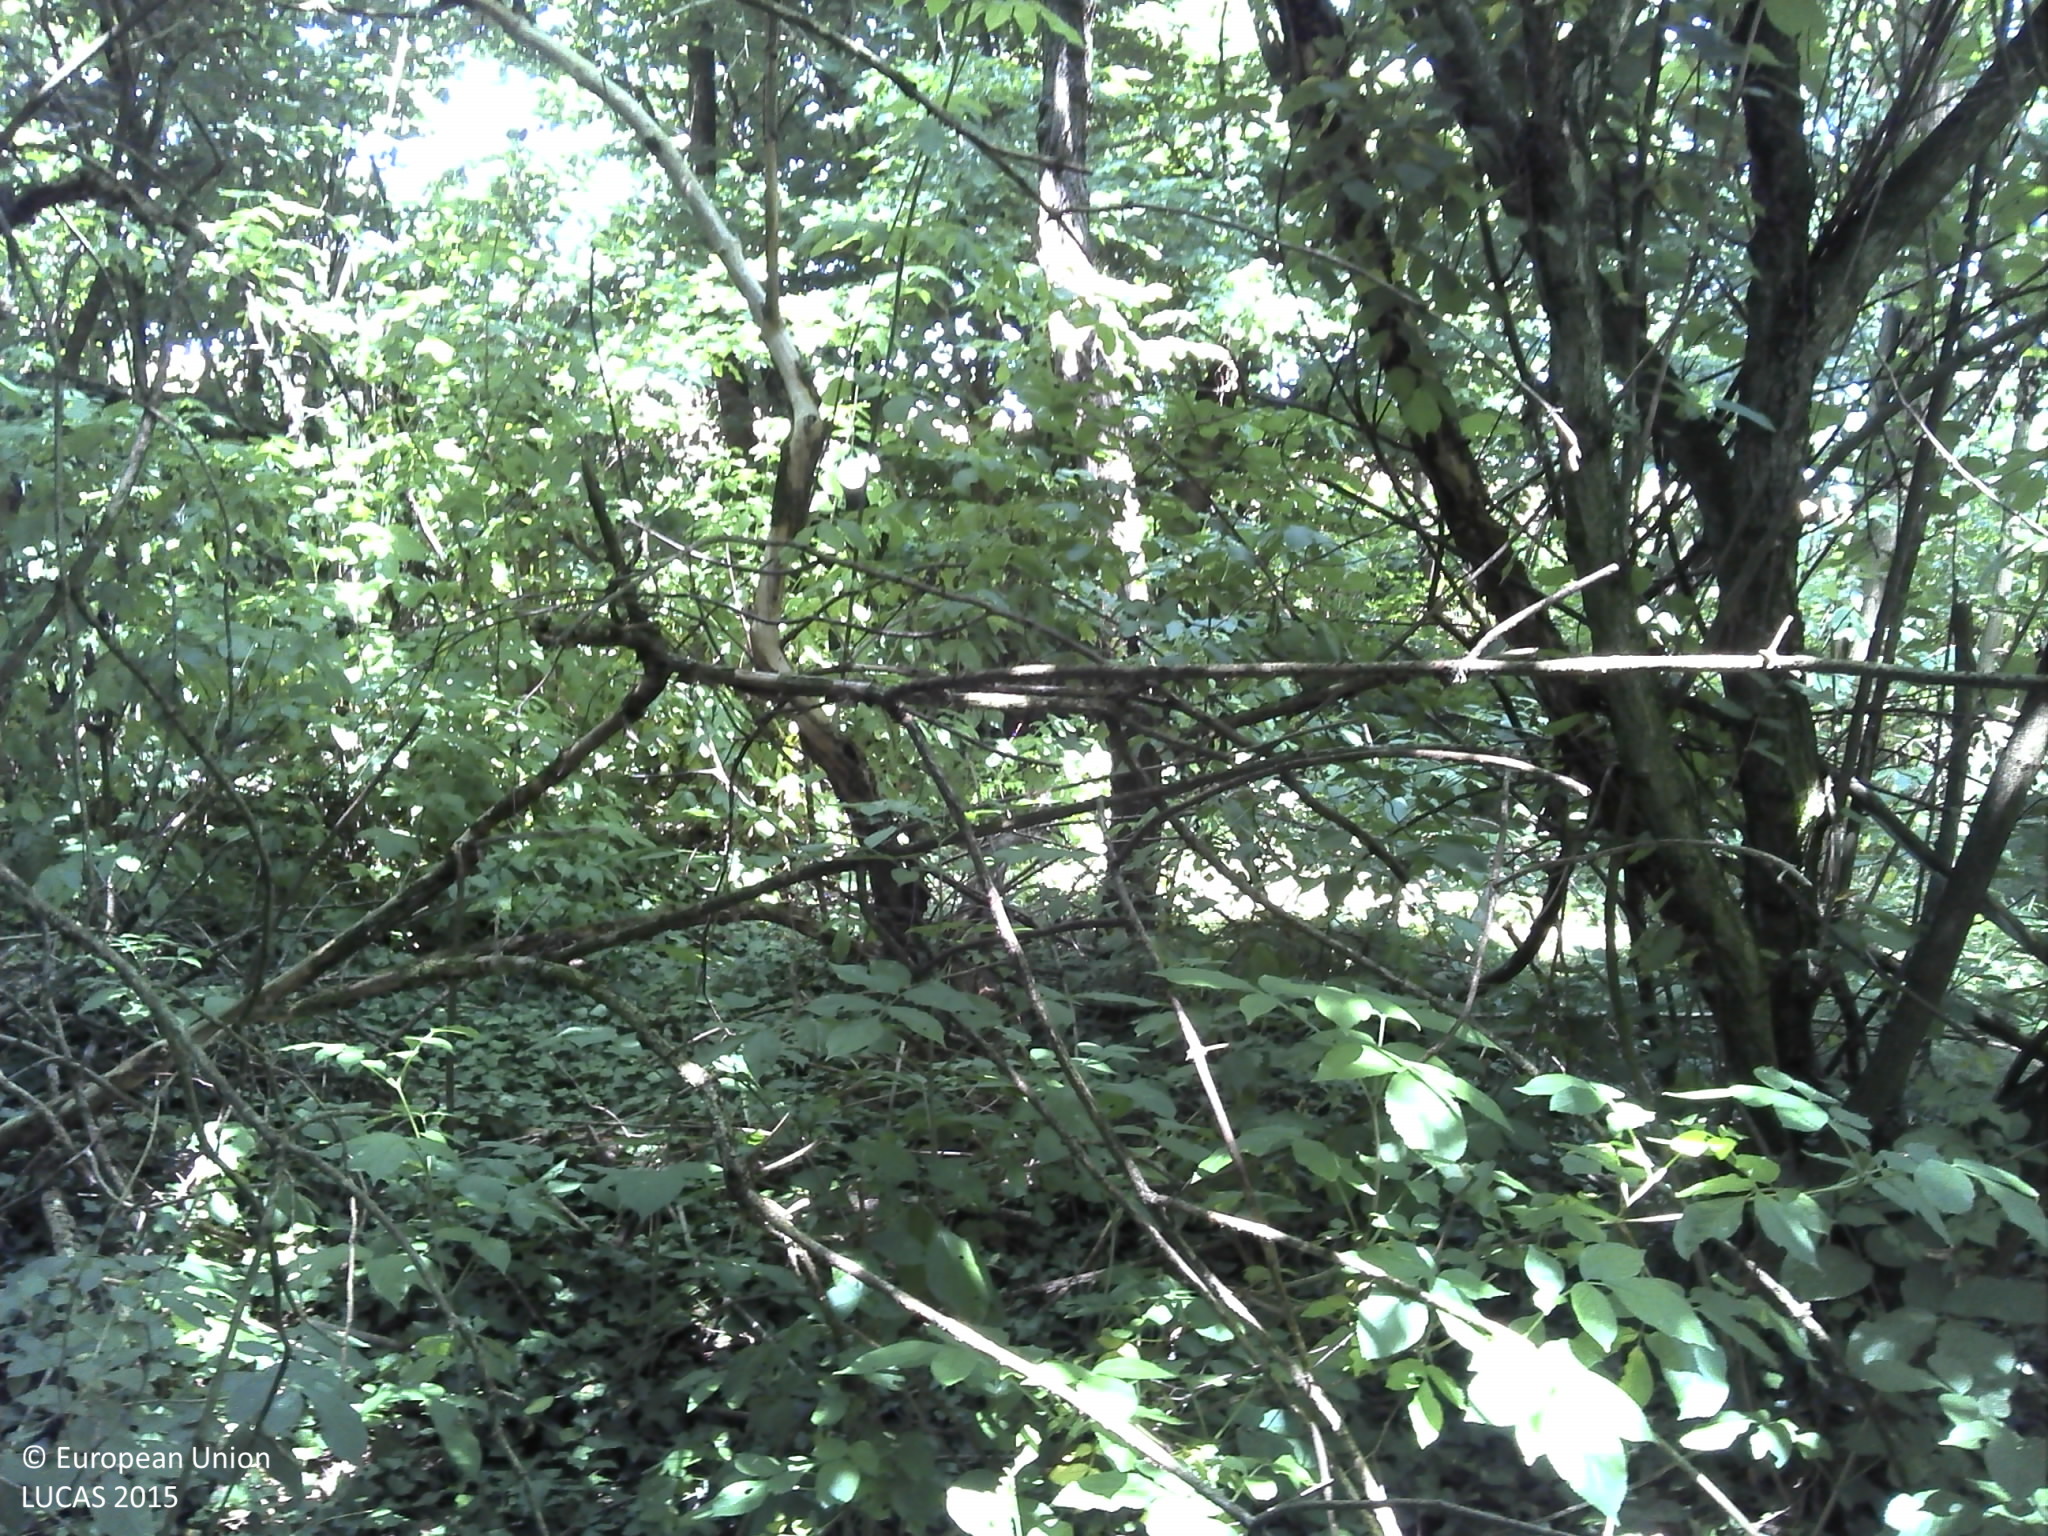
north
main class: Shrubland
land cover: Shrubland with sparse tree cover
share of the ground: > 75 %
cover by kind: shrubs 95 %, broadleaved forest trees 5 %
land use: Semi-natural and natural areas not in use
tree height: < 5 m
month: July
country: HR
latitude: 45.5350
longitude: 16.8503
